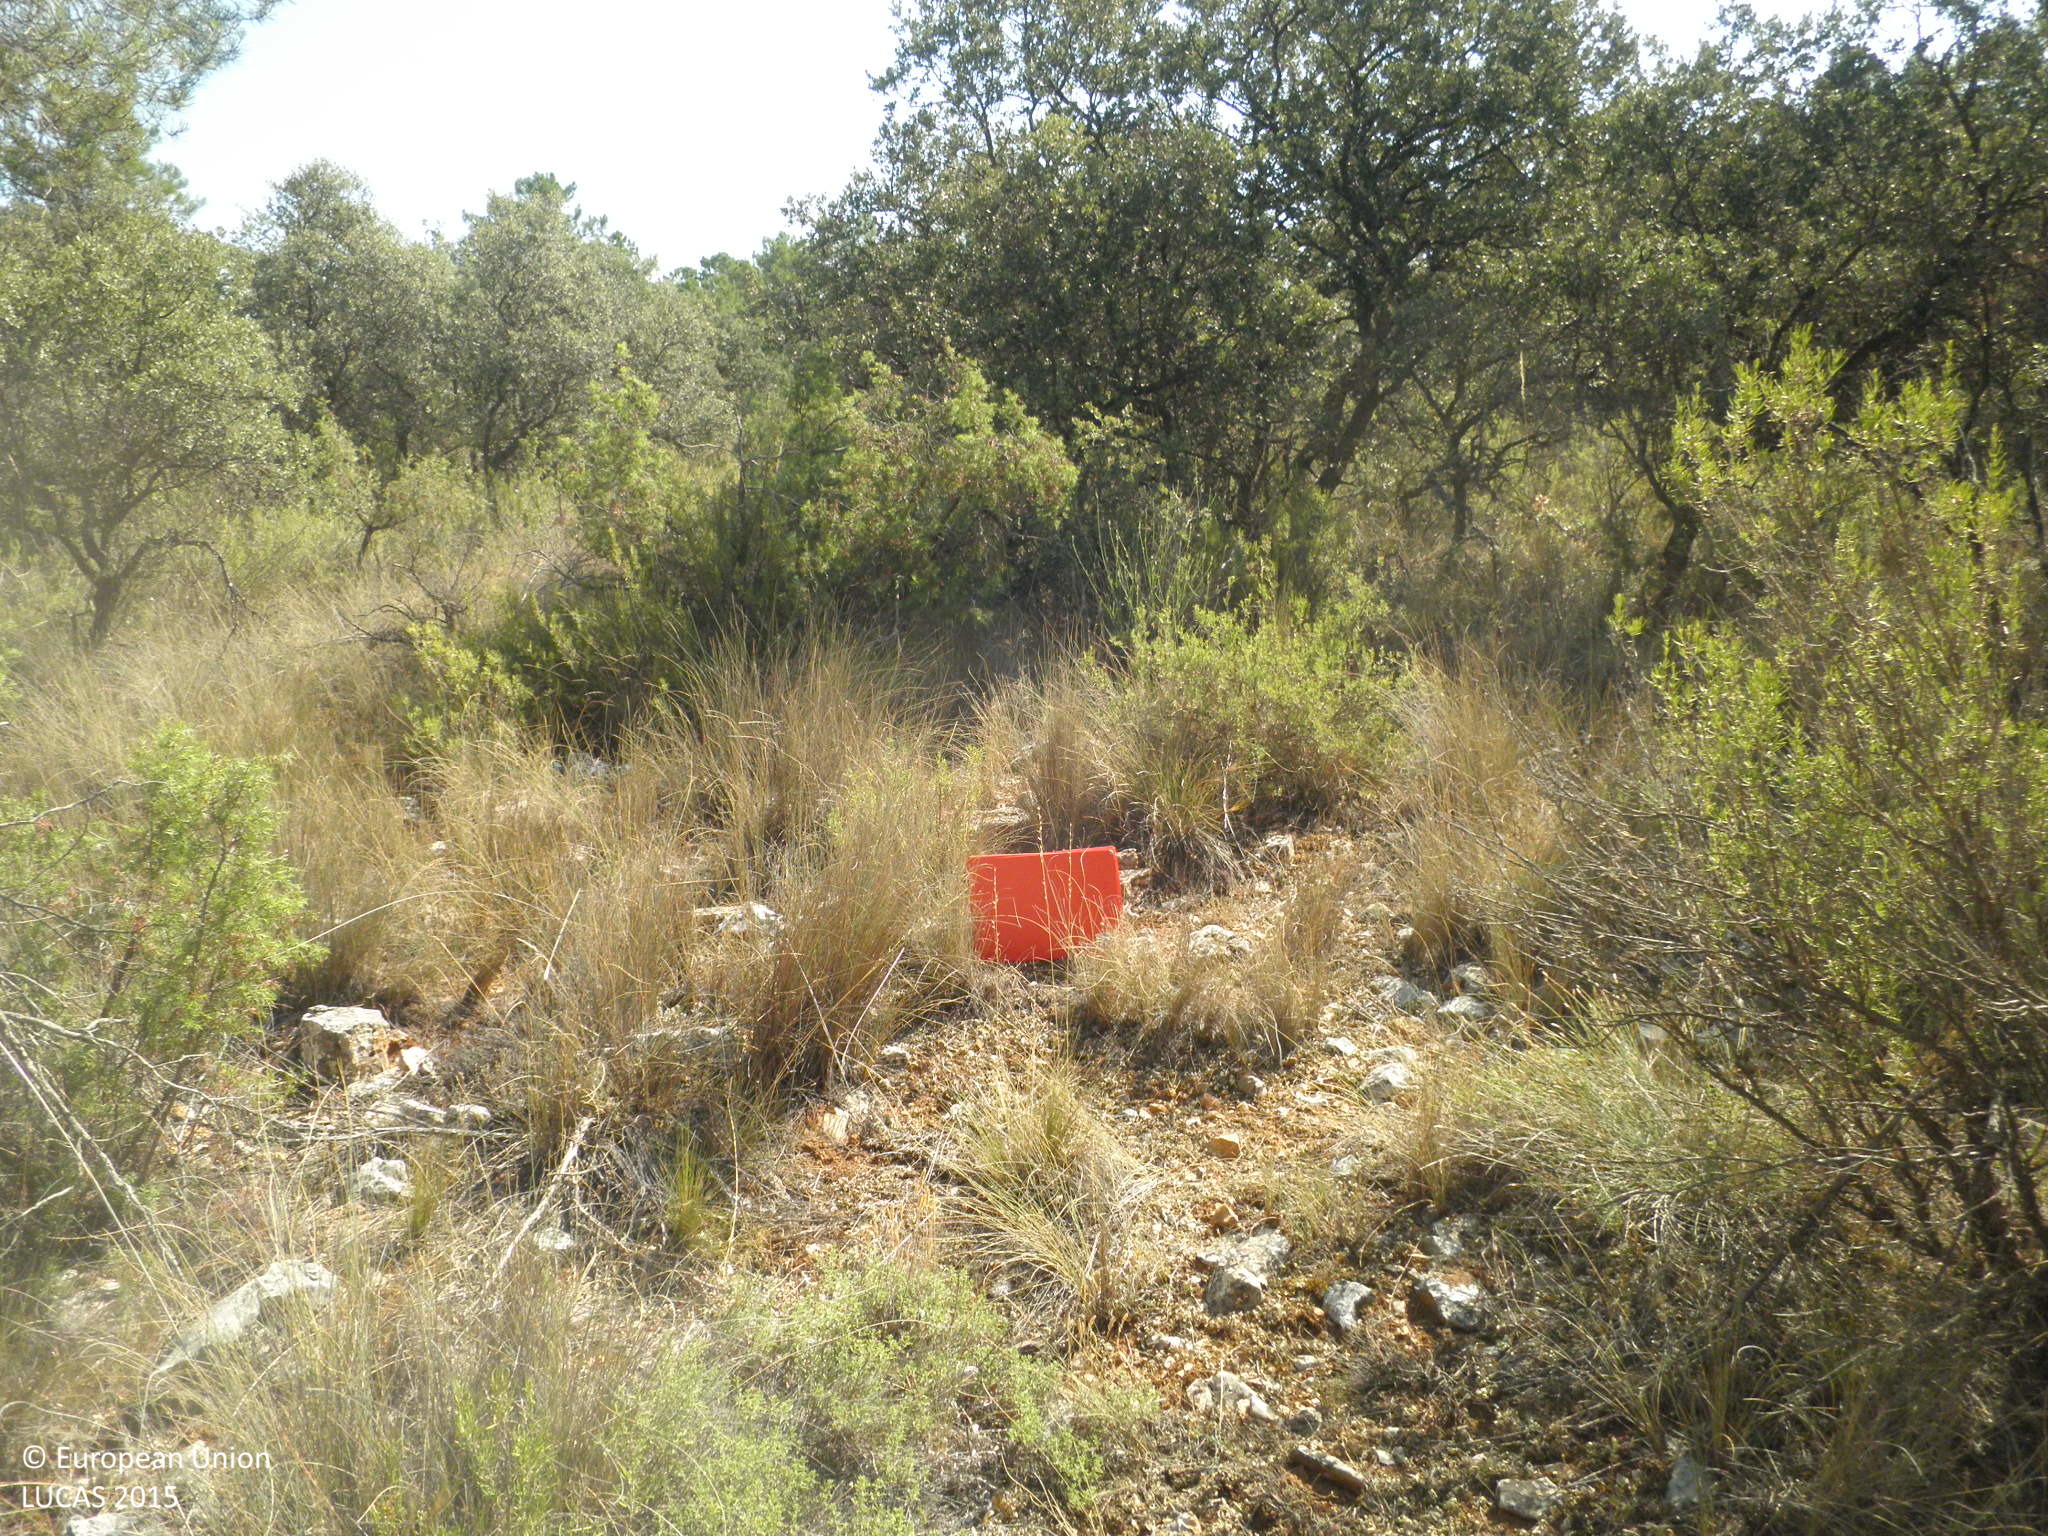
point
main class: Woodland
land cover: Pine dominated mixed woodland
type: coniferous forest of the mediterranean region
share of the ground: 25 - 50 %
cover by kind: coniferous forest trees 25 %, unconsolidated bare surface 25 %, broadleaved forest trees 20 %, shrubs 15 %, herbaceous plants 15 %
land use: Semi-natural and natural areas not in use
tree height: > 5 m
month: July
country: ES
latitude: 39.6302
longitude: -1.7630
